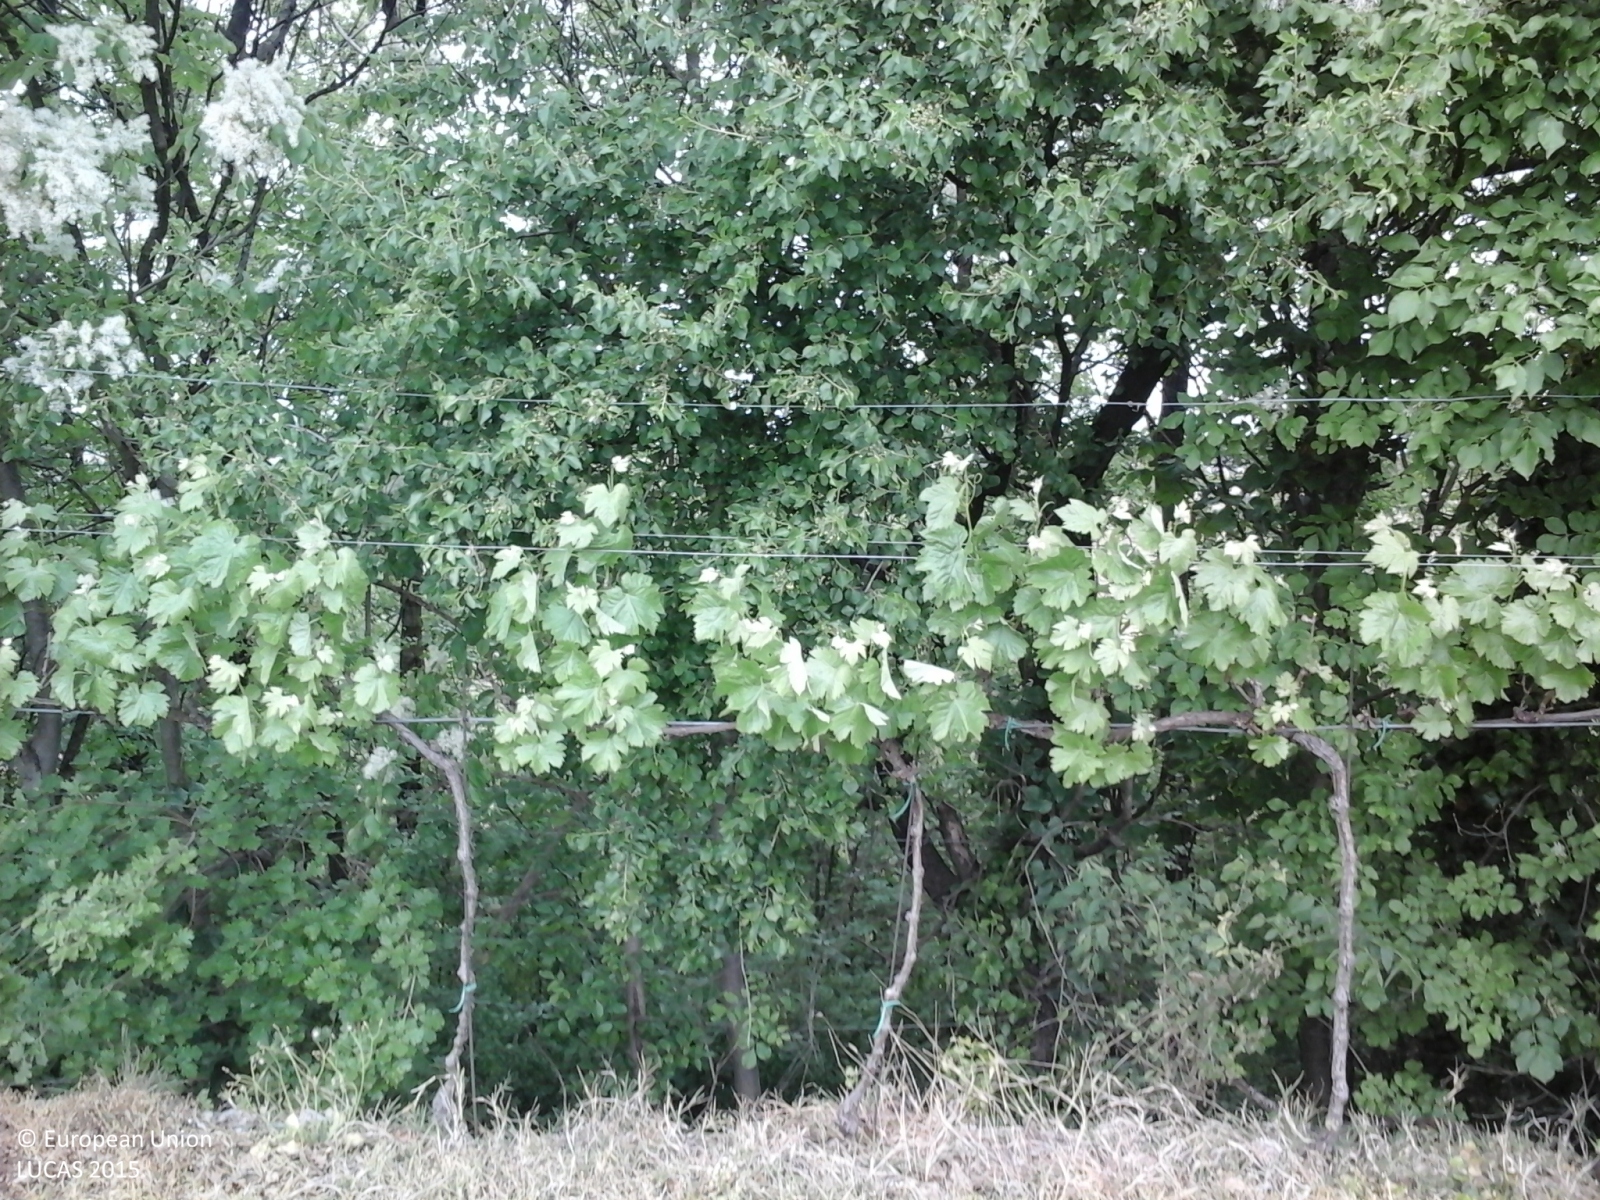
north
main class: Woodland
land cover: Broadleaved woodland
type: mesophytic deciduous forest
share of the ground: > 75 %
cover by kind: broadleaved forest trees 100 %
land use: Semi-natural and natural areas not in use
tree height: > 5 m
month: April
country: IT
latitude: 45.3584
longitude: 10.6244
